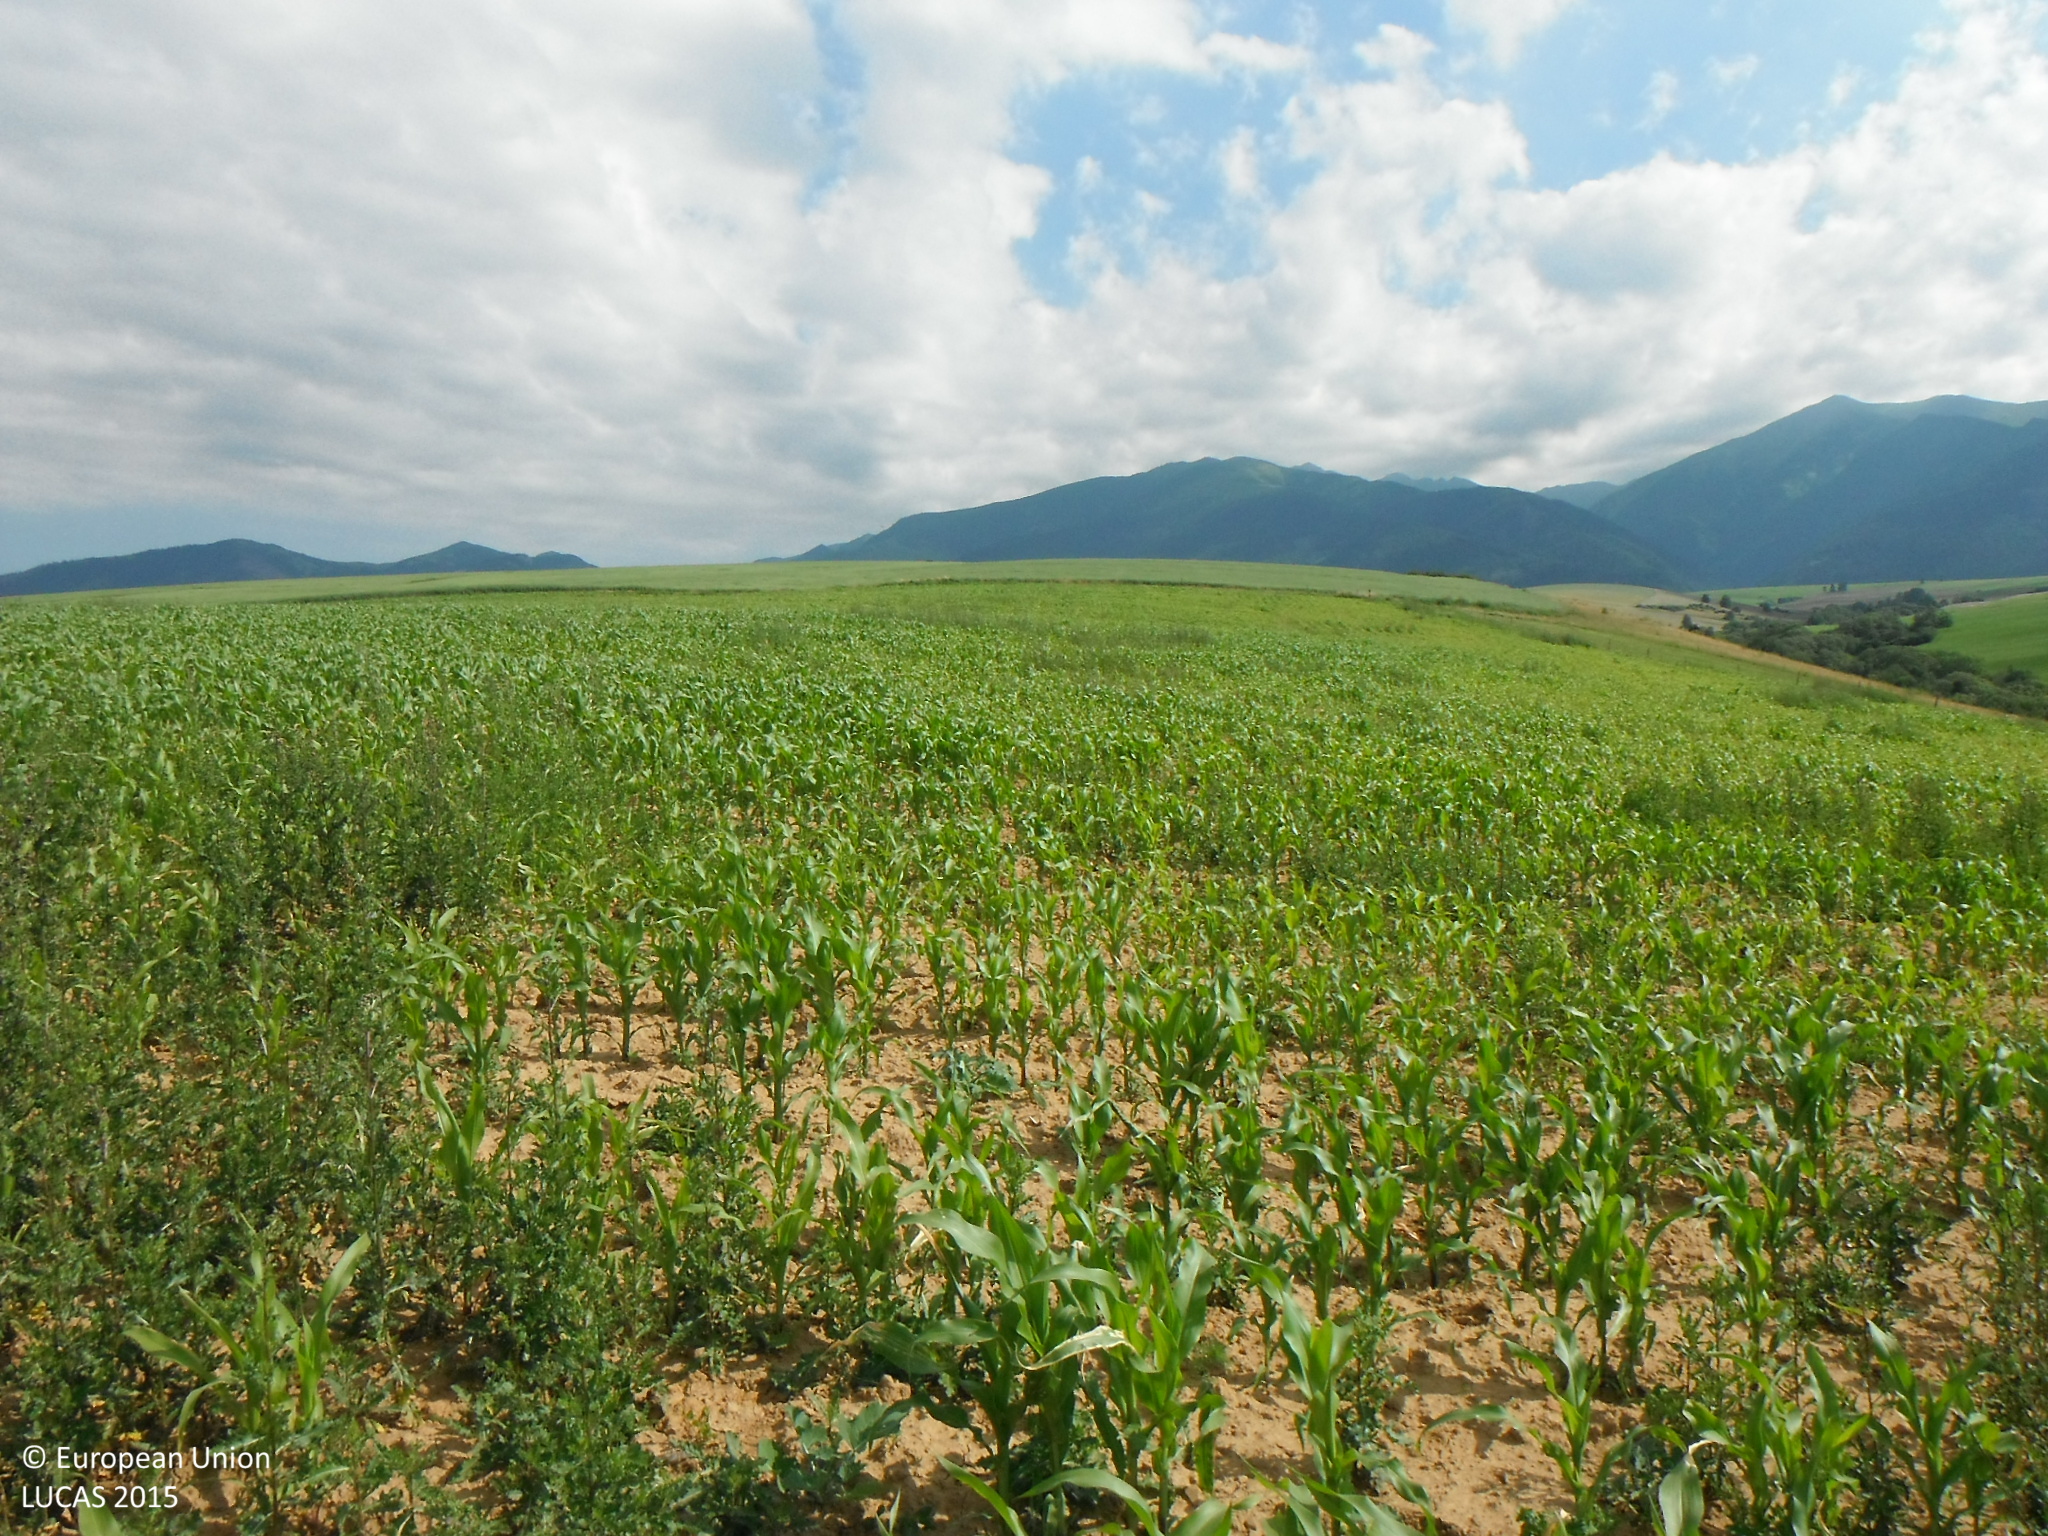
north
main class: Cropland
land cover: Maize
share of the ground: 50 - 75 %
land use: Agriculture (excluding fallow land and kitchen gardens)
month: July
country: SK
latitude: 49.1032
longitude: 19.6567
